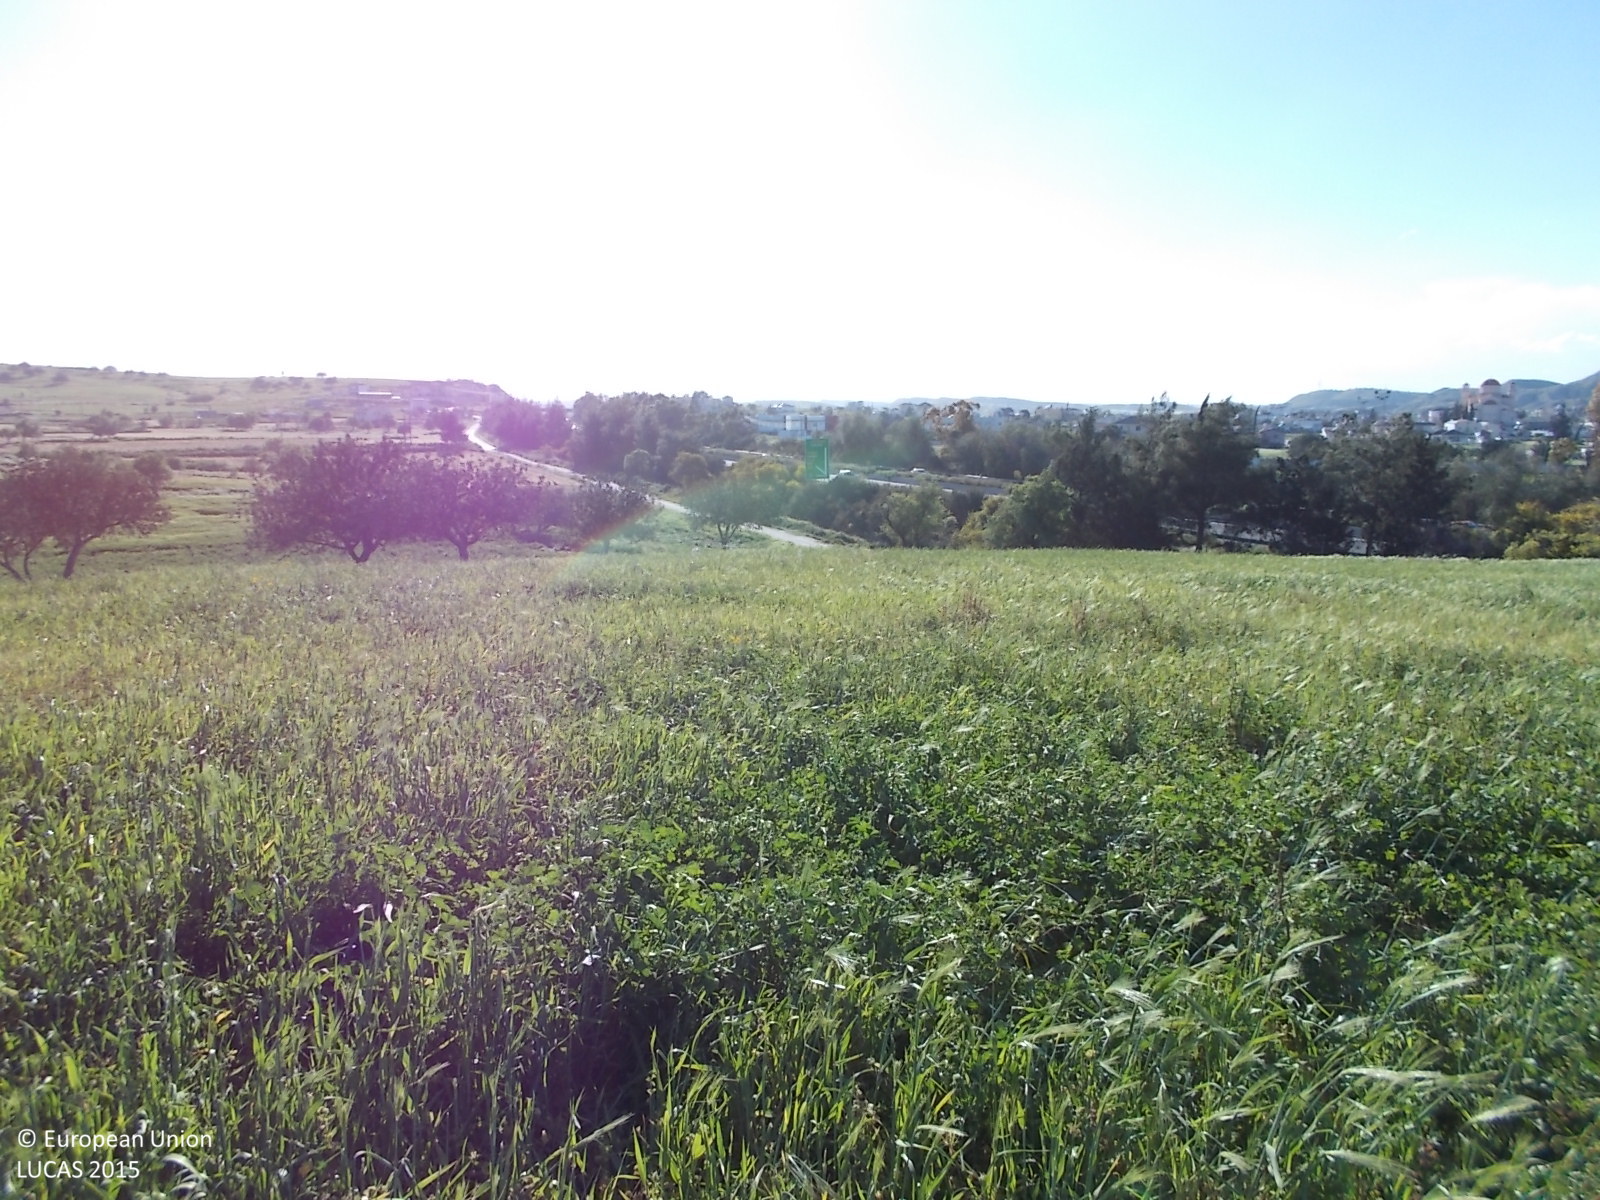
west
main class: Cropland
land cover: Mixed cereals for fodder
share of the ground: > 75 %
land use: Agriculture (excluding fallow land and kitchen gardens)
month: April
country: CY
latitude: 34.9908
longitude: 33.4730
